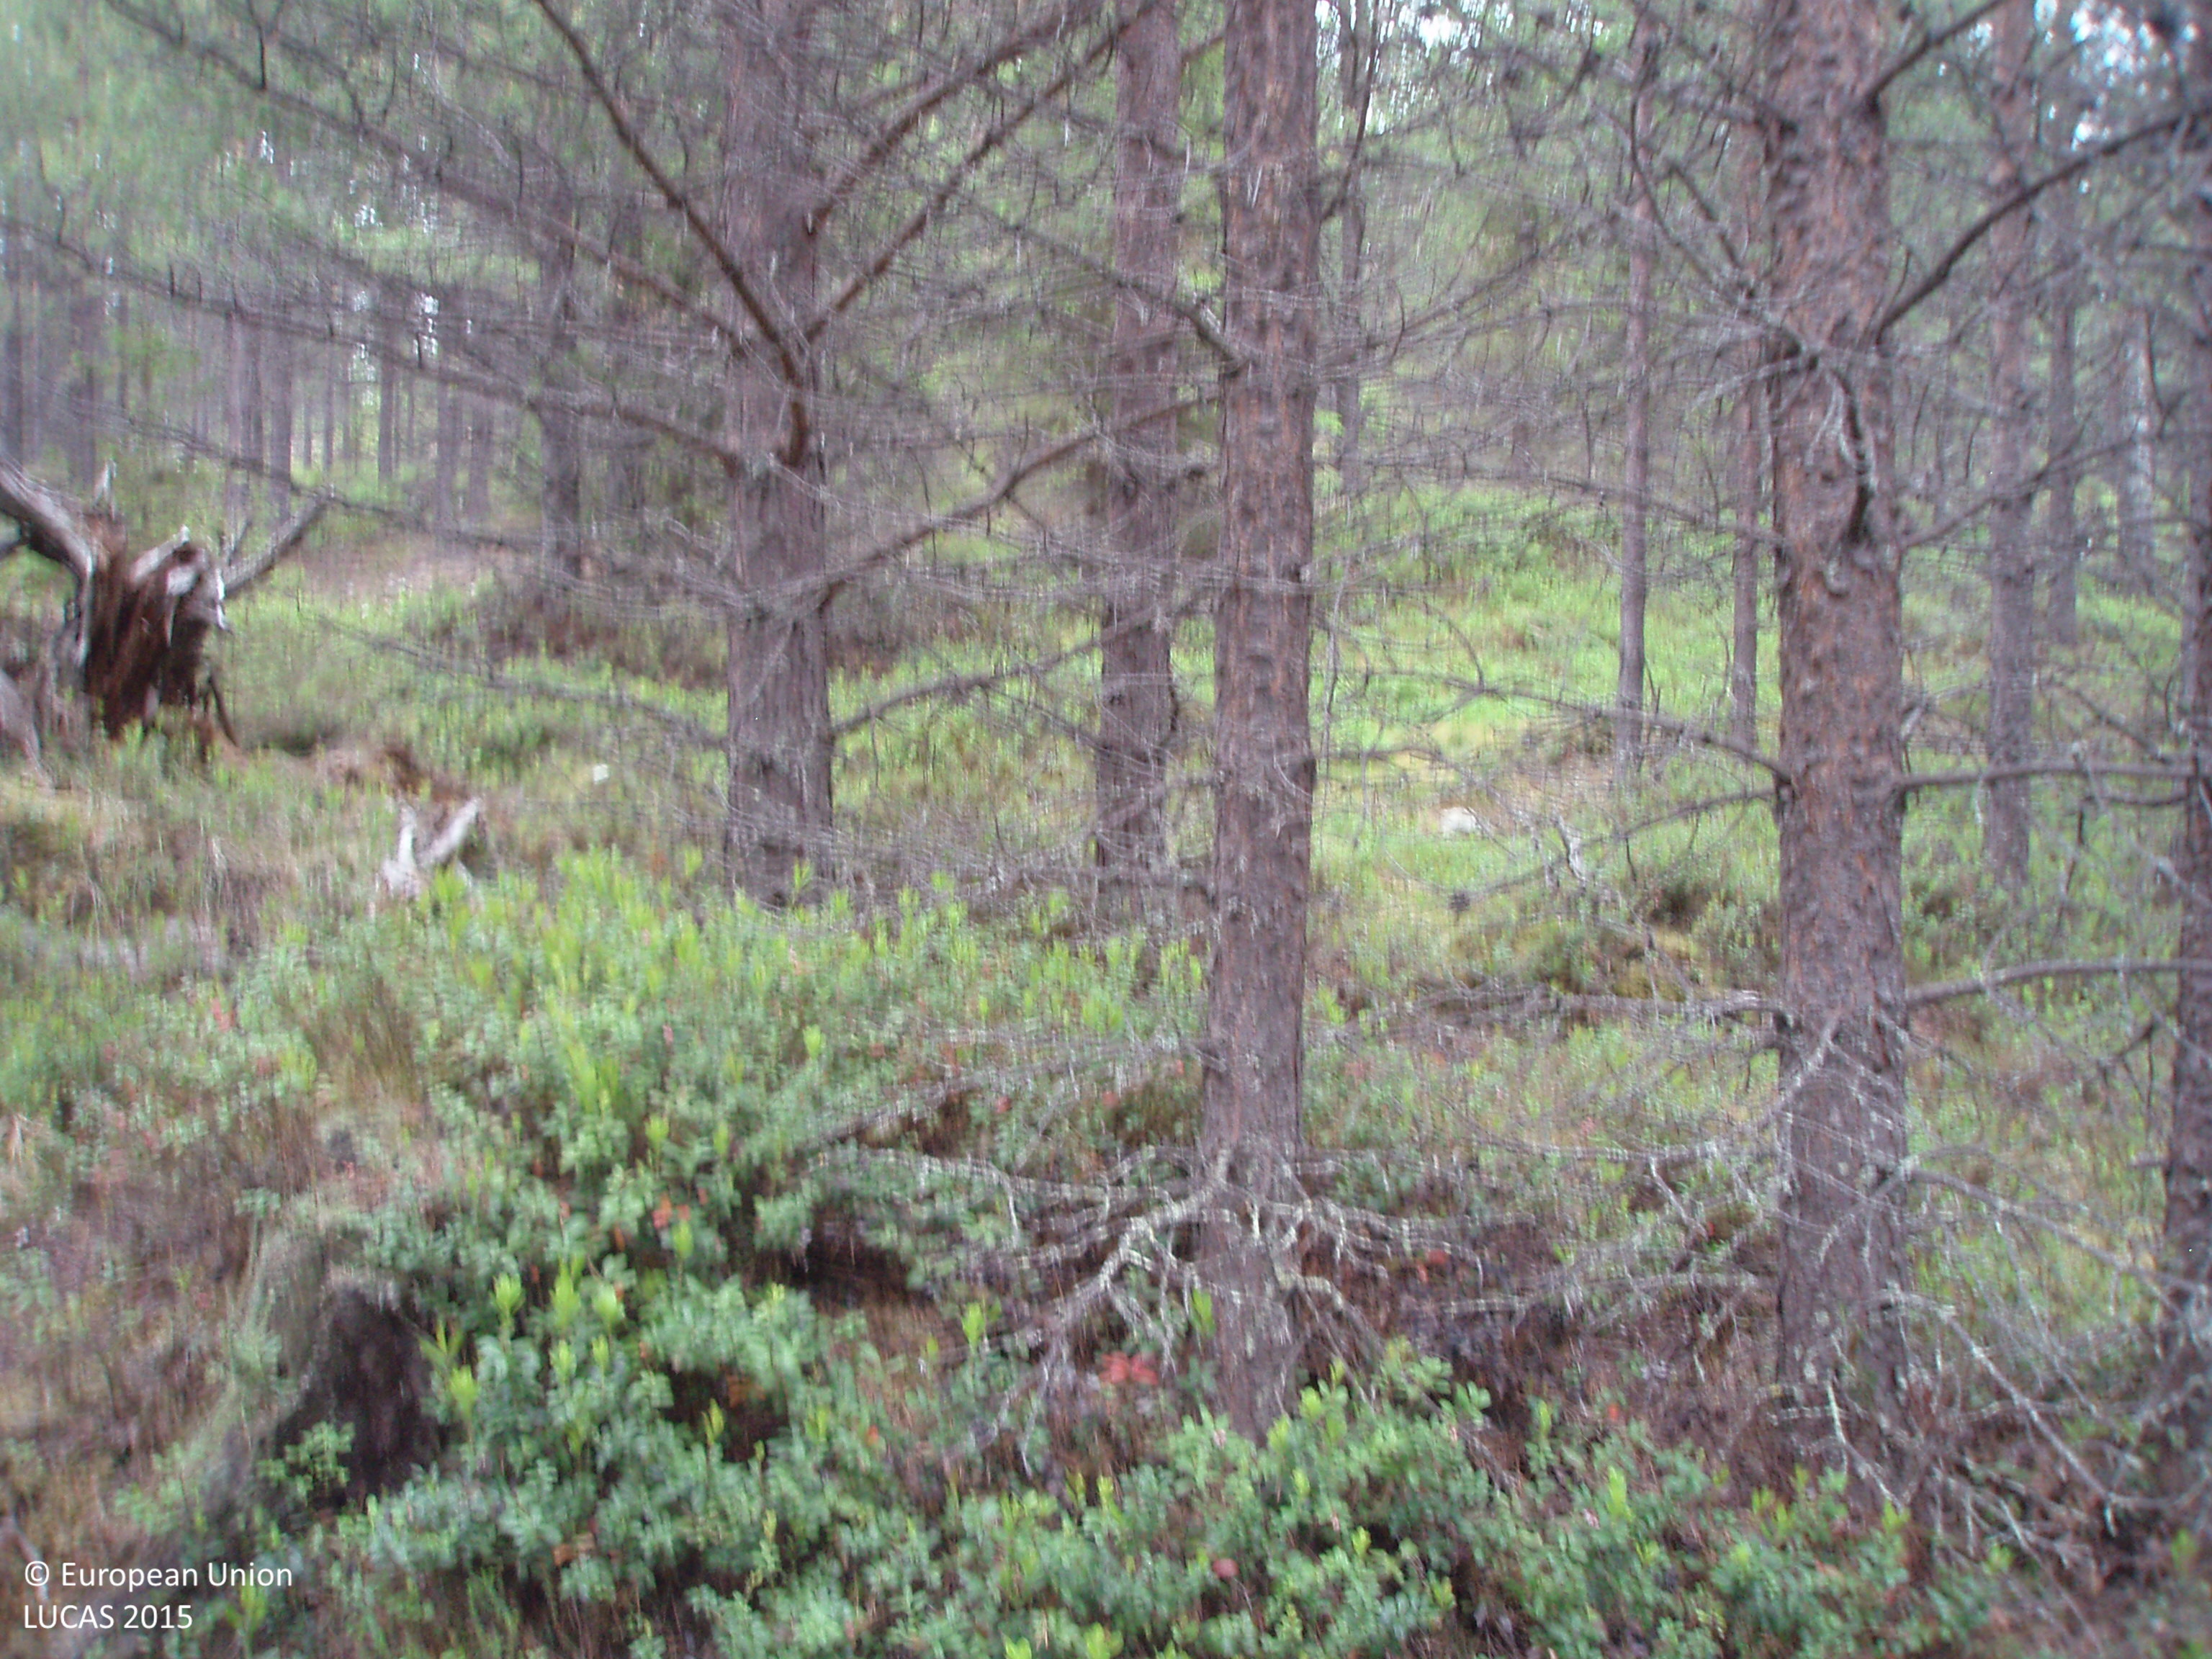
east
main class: Woodland
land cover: Pine dominated coniferous woodland
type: boreal forest
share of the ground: > 75 %
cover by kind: coniferous forest trees 90 %, shrubs 10 %
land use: Forestry
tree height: > 5 m
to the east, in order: Pine dominated coniferous woodland; Ditches and canals; Pine dominated coniferous woodland; Ditches and canals; Pine dominated coniferous woodland; Tracks; Ditches and canals; Pine dominated coniferous woodland; Ditches and canals; Pine dominated coniferous woodland; Ditches and canals; Pine dominated coniferous woodland; Ditches and canals; Tracks; Ditches and canals; Pine dominated coniferous woodland; Ditches and canals; Pine dominated coniferous woodland; Ditches and canals; Pine dominated coniferous woodland; Ditches and canals; Pine dominated coniferous woodland; Ditches and canals; Pine dominated coniferous woodland; Ditches and canals; Pine dominated coniferous woodland; Ditches and canals; Pine dominated coniferous woodland; Ditches and canals; Pine dominated coniferous woodland
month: July
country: FI
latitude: 67.4833
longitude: 28.8853
